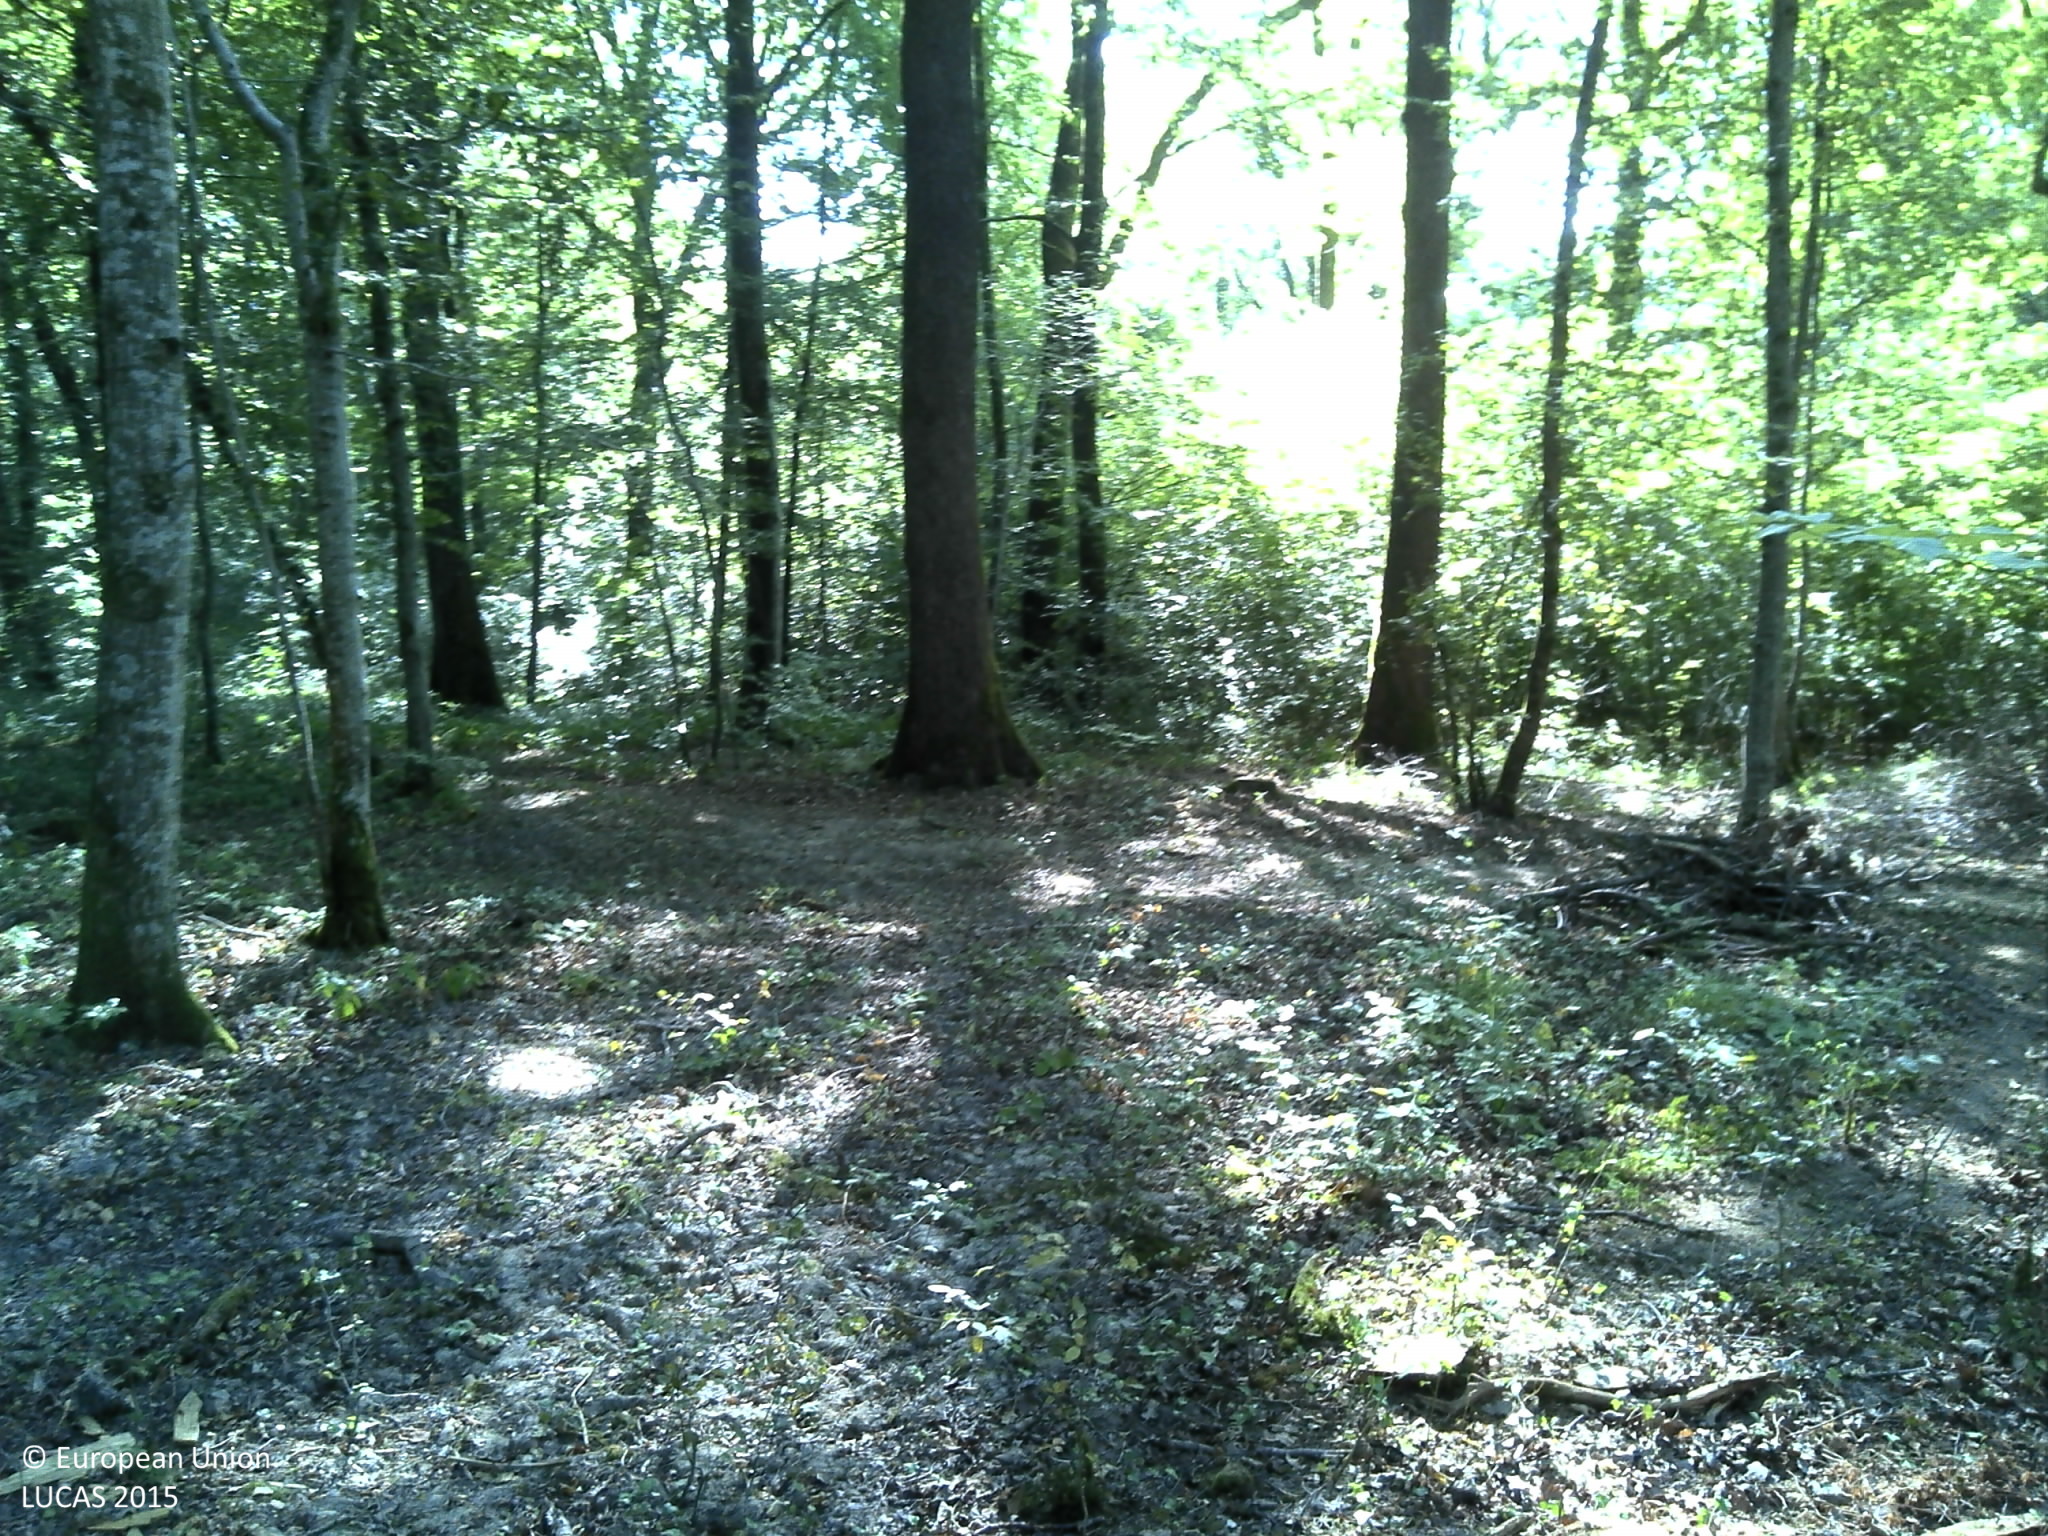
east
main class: Woodland
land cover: Broadleaved woodland
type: beech forest
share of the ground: > 75 %
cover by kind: broadleaved forest trees 100 %
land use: Forestry
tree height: > 5 m
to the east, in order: Broadleaved woodland
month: July
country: FR
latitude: 48.2620
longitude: 6.0803
